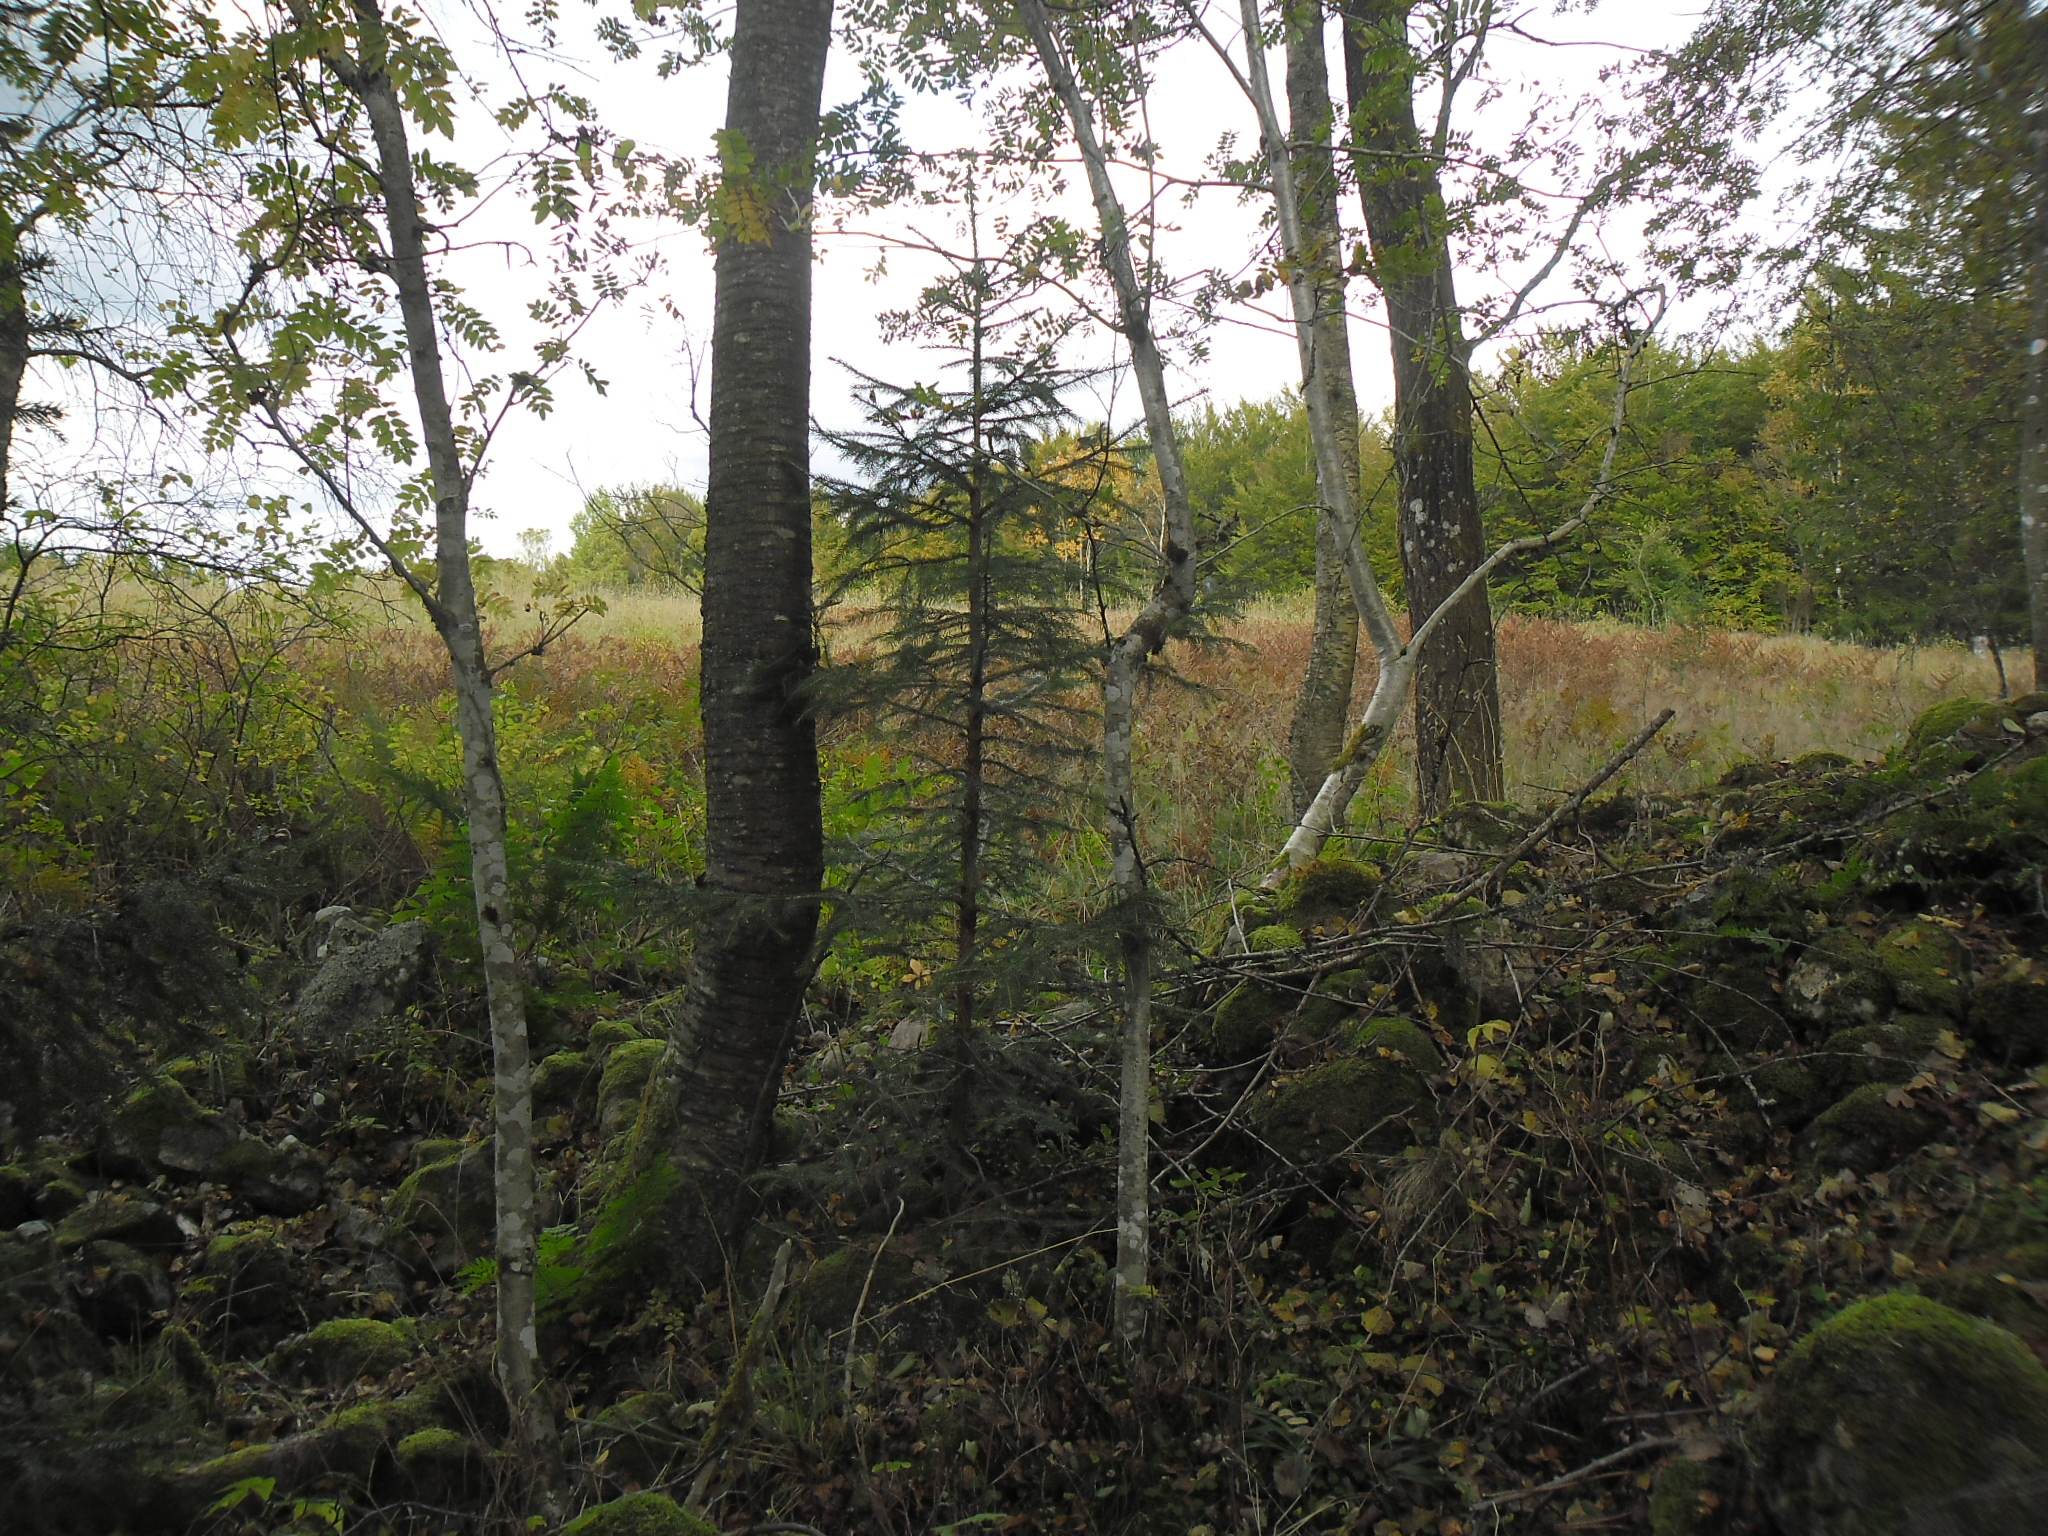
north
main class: Woodland
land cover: Broadleaved woodland
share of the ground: > 75 %
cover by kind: broadleaved forest trees 85 %, shrubs 15 %
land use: Forestry
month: October
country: SE
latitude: 56.6335
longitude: 13.2085
